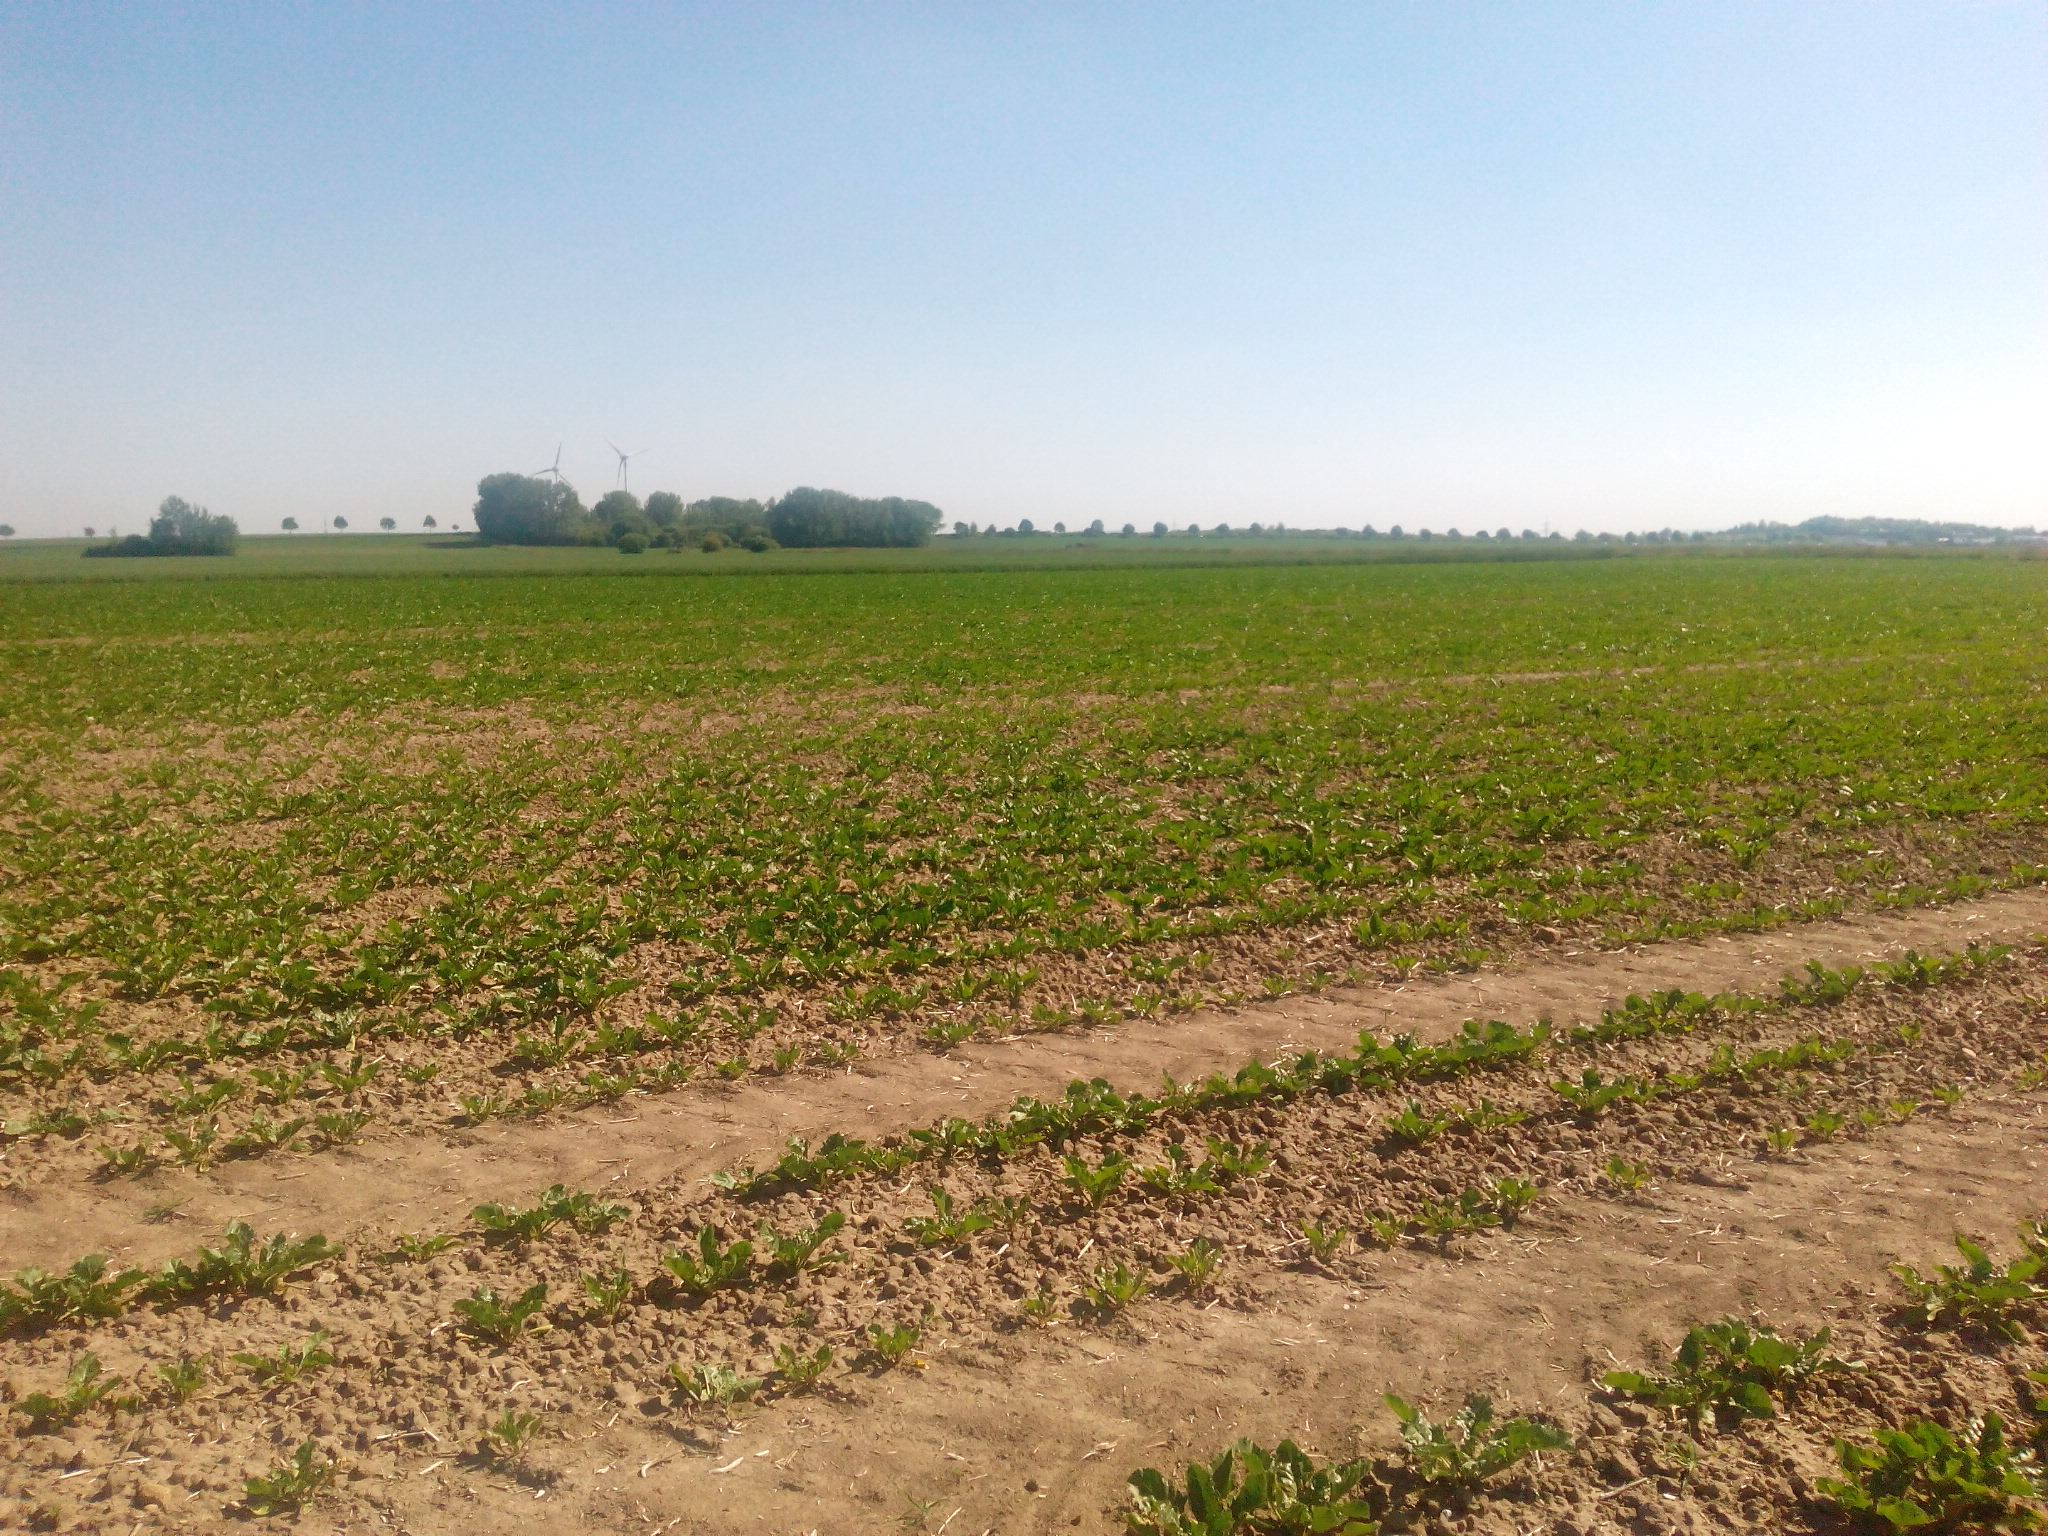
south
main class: Cropland
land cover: Sugar beet
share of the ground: 25 - 50 %
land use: Agriculture (excluding fallow land and kitchen gardens)
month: June
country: DE
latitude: 52.2875
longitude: 9.8681
